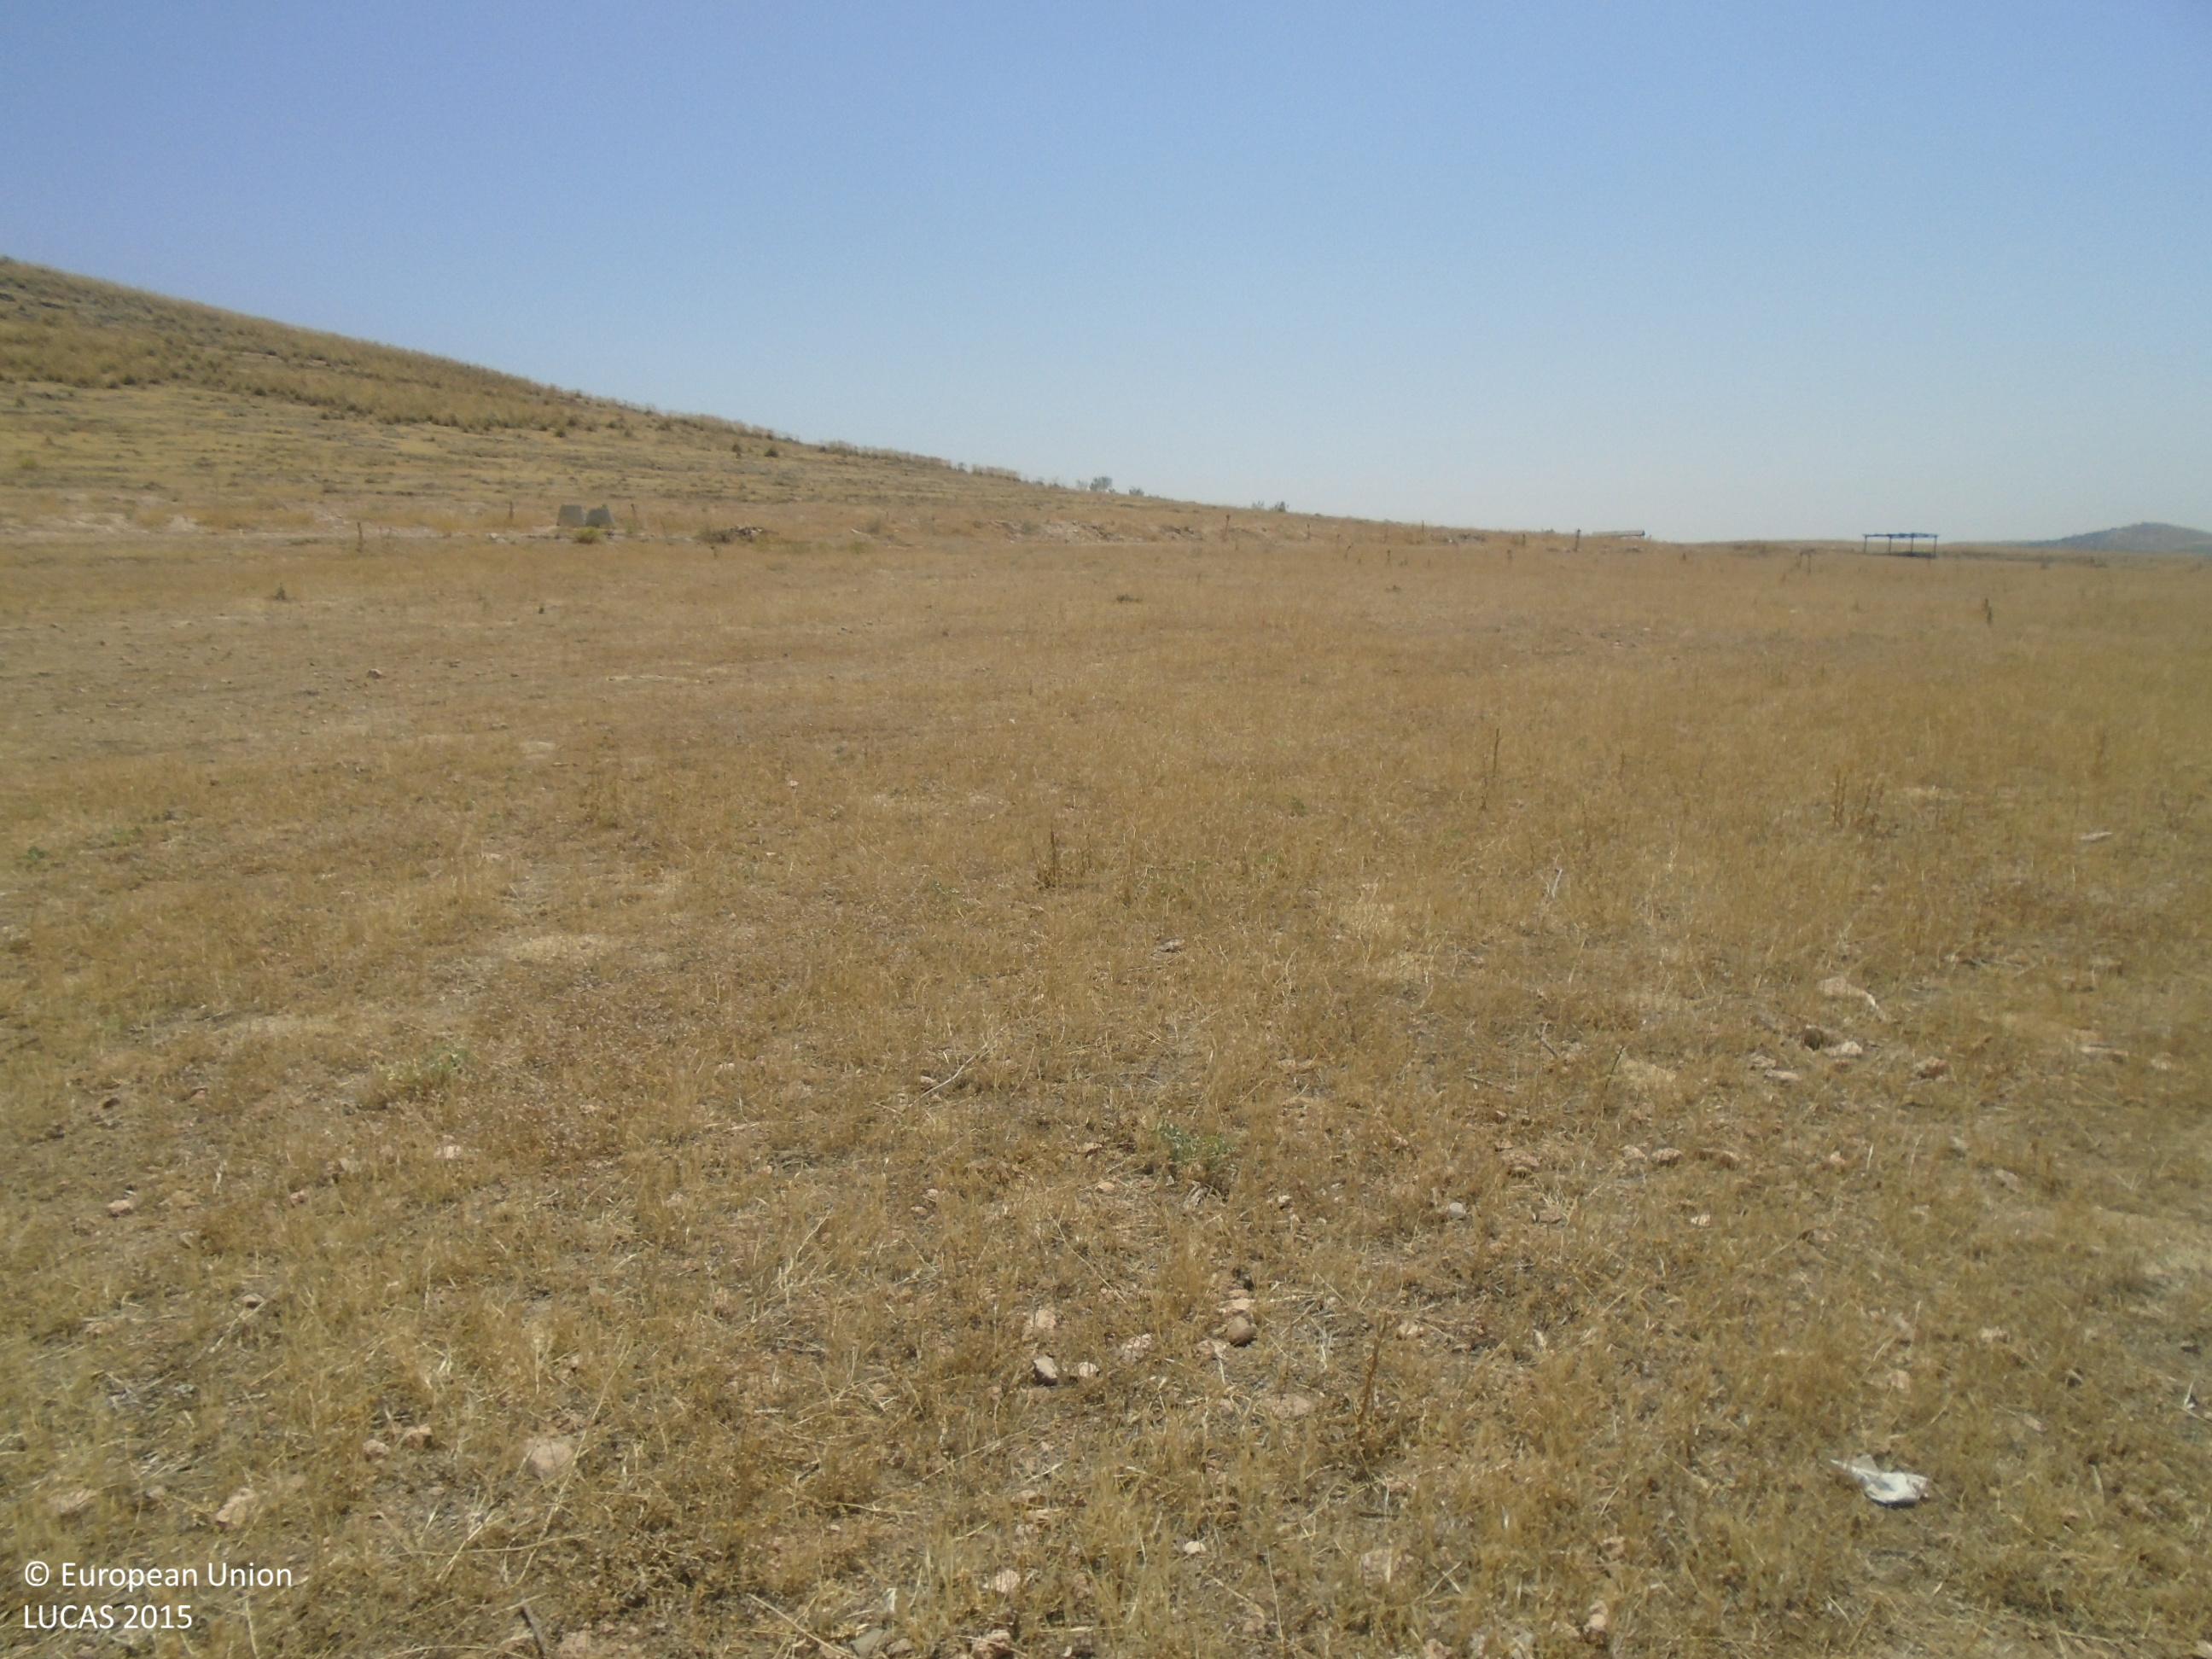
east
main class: Grassland
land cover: Grassland without tree/shrub cover
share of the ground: > 75 %
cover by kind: herbaceous plants 100 %
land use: Agriculture (excluding fallow land and kitchen gardens)
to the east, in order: Grass margins; Fences; Grassland without tree/shrub cover; Tracks; Artificial constructions; Grassland without tree/shrub cover; Rock outcrops; Grassland without tree/shrub cover; Shrubland without tree cover; Rock outcrops; Grassland without tree/shrub cover; Rock outcrops
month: July
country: ES
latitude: 39.4428
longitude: -3.6063
